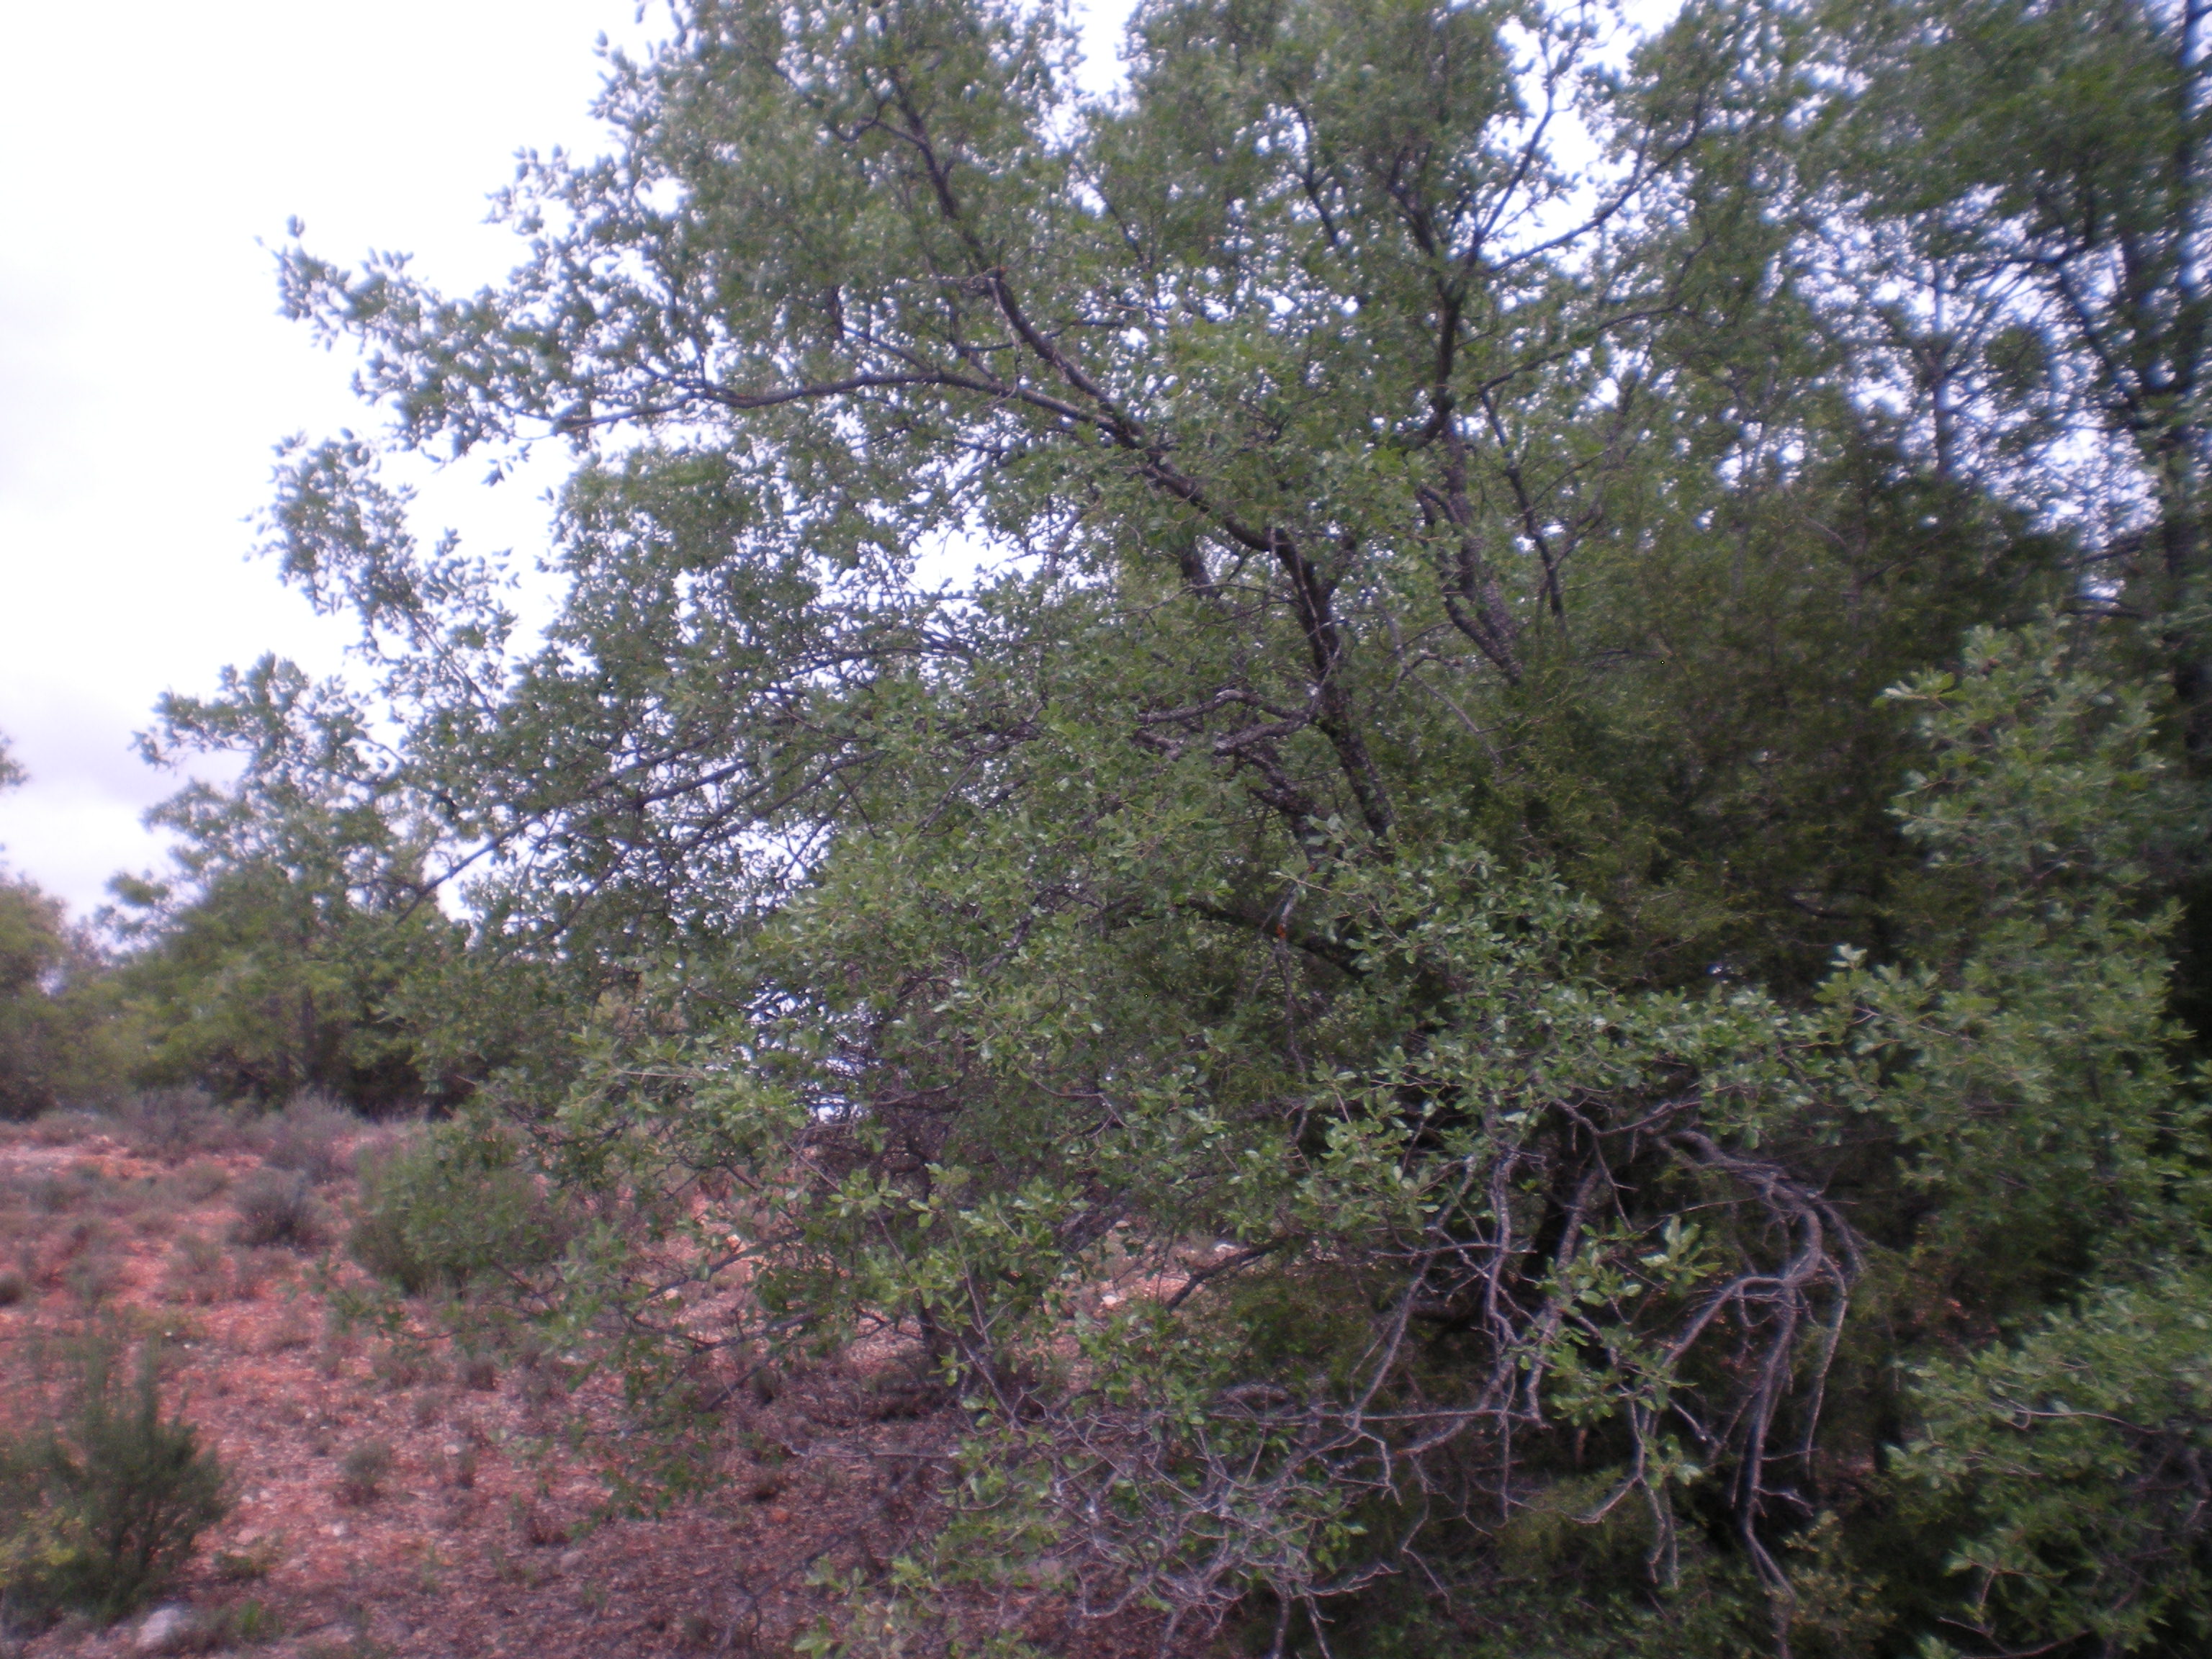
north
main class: Woodland
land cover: Broadleaved woodland
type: broadleaved evergreen forest
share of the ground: 50 - 75 %
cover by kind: shrubs 50 %, unconsolidated bare surface 35 %, broadleaved forest trees 15 %
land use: Other primary production
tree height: < 5 m
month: May
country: ES
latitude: 38.8413
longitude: -2.9224
